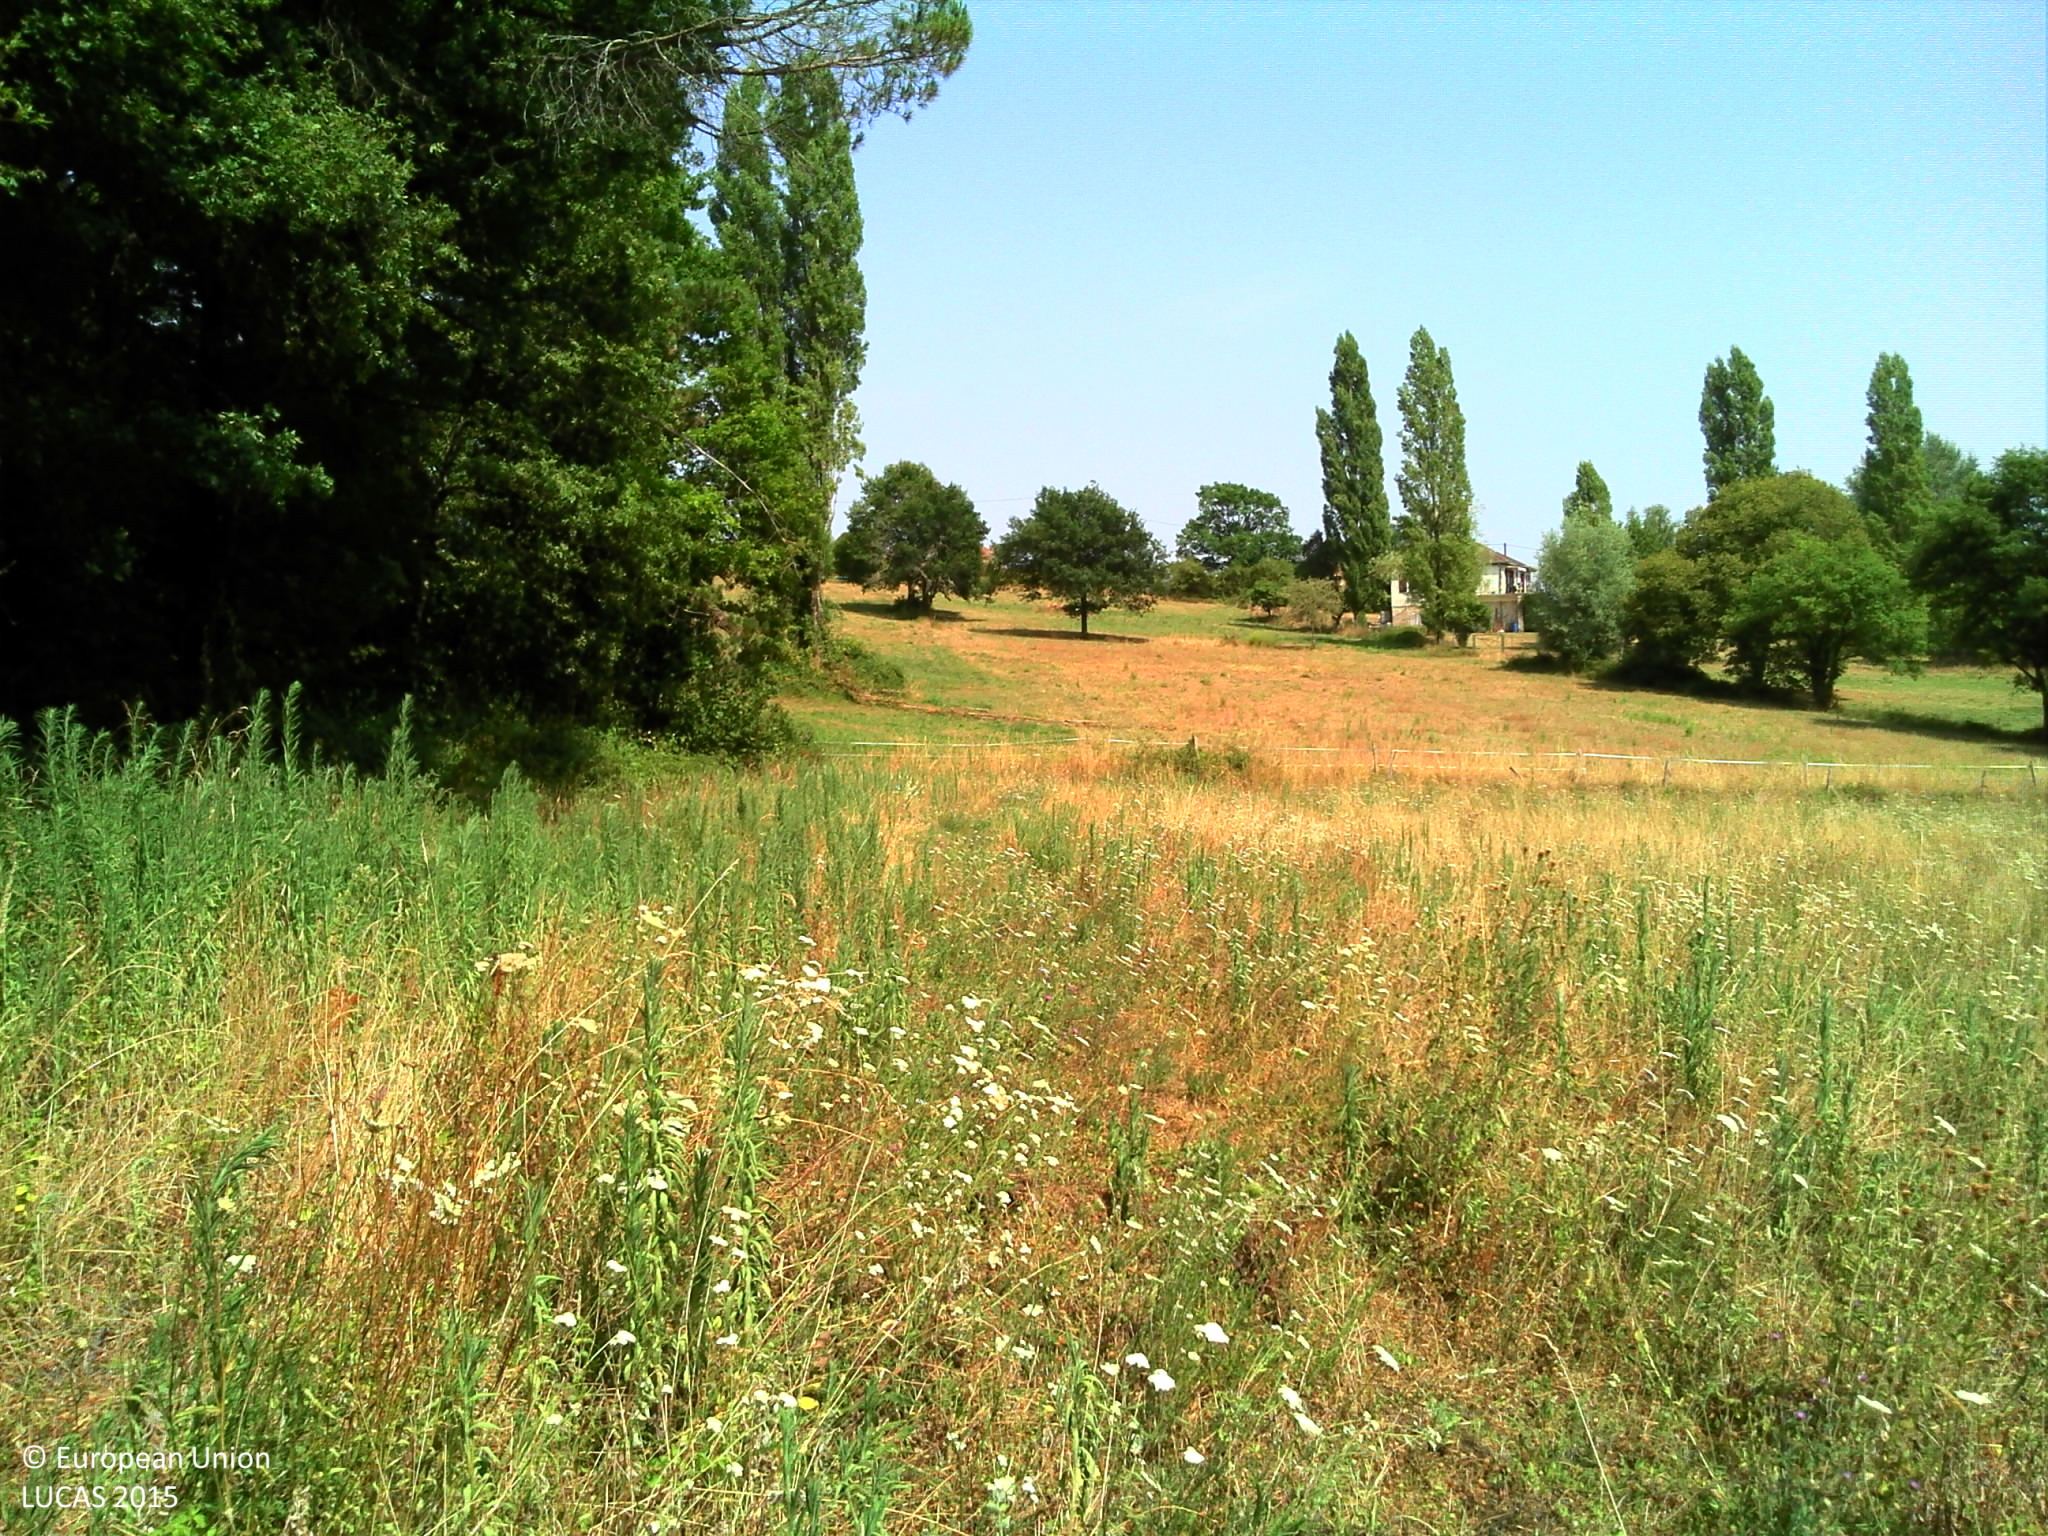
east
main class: Grassland
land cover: Grassland without tree/shrub cover
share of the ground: > 75 %
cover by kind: herbaceous plants 100 %
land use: Agriculture (excluding fallow land and kitchen gardens)
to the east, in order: Grassland without tree/shrub cover; Fences; Grassland without tree/shrub cover; Single bushes/trees; Grassland without tree/shrub cover; Abandoned hedges; Artificial constructions in urban areas
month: July
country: FR
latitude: 45.1527
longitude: 1.1785
